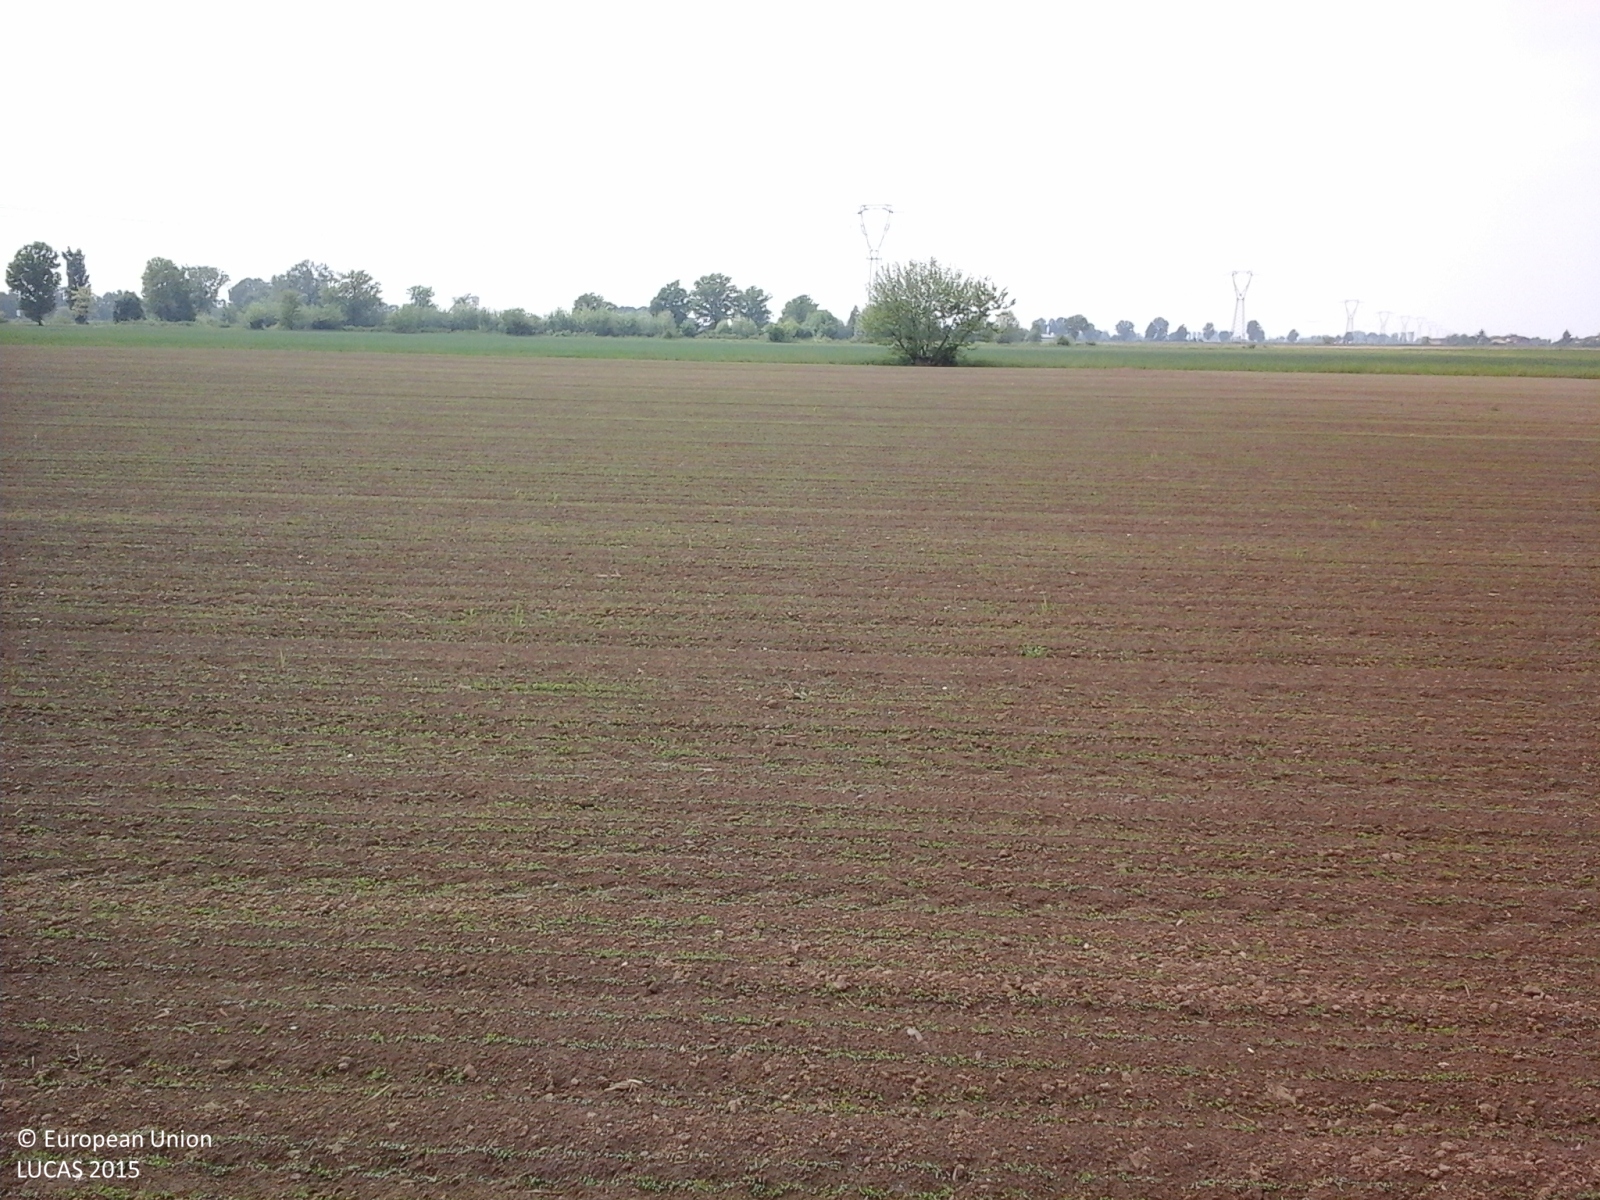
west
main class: Cropland
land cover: Lucerne
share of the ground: < 10 %
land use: Agriculture (excluding fallow land and kitchen gardens)
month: May
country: IT
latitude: 45.0894
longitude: 10.2917
